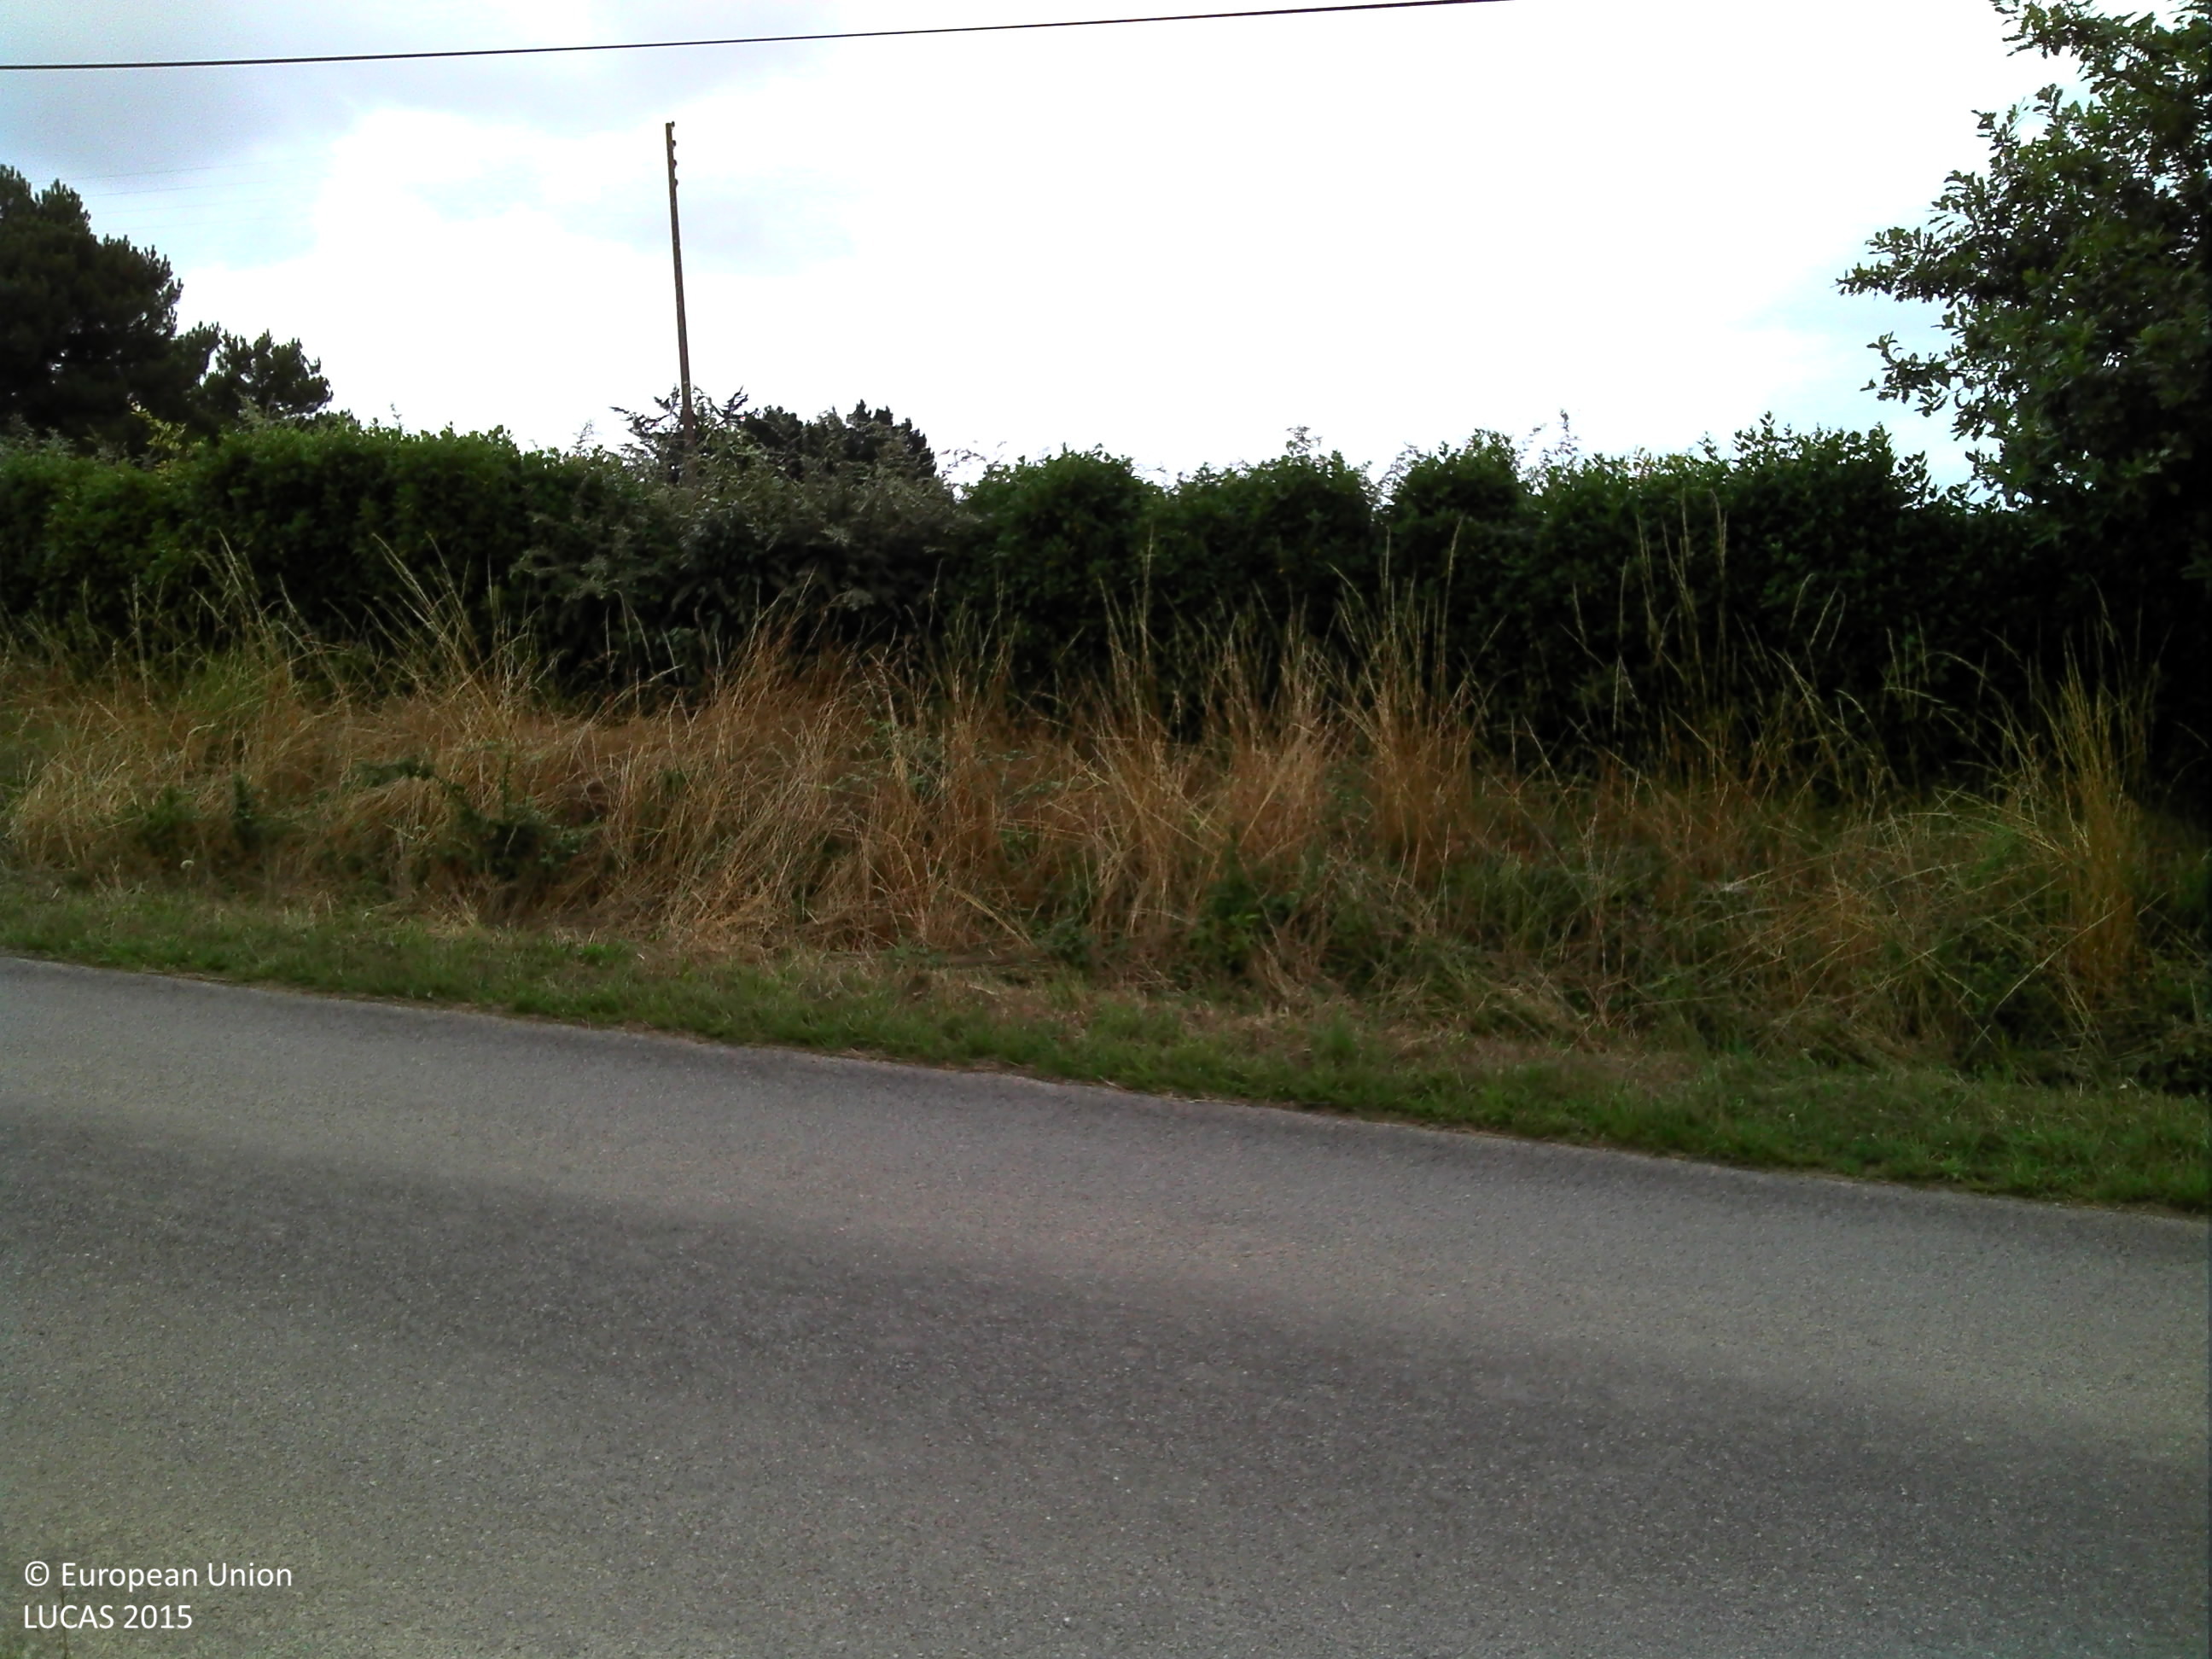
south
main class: Cropland
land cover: Triticale
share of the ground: > 75 %
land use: Agriculture (excluding fallow land and kitchen gardens)
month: July
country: FR
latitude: 47.6043
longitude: -2.9270
